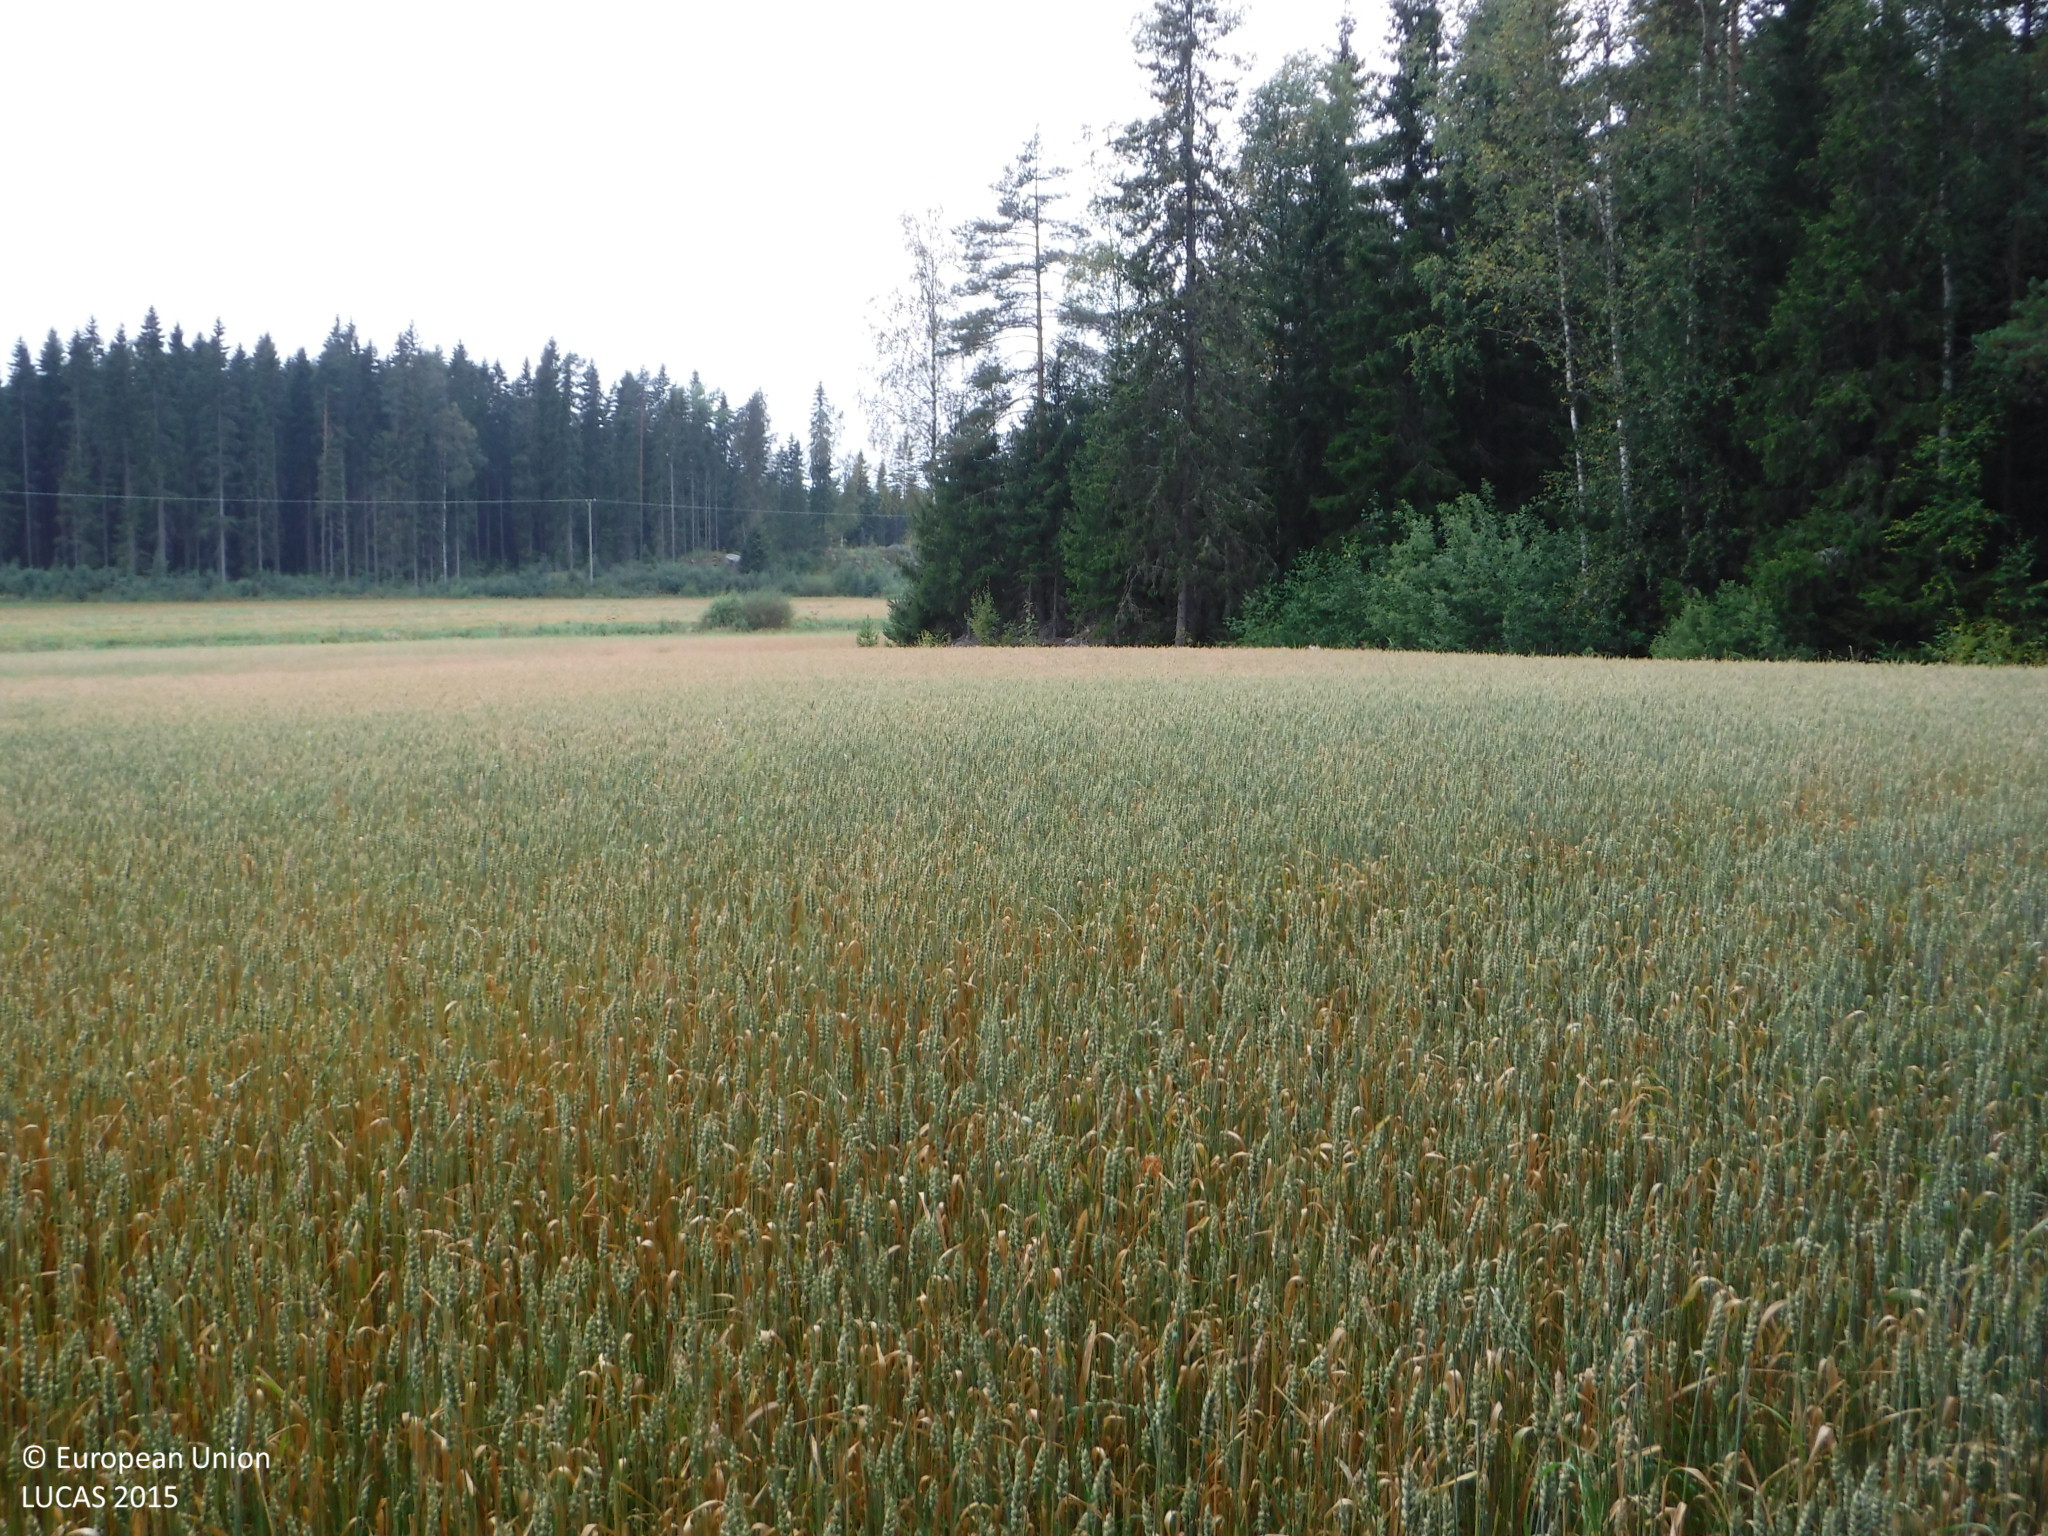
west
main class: Cropland
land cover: Common wheat
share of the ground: > 75 %
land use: Agriculture (excluding fallow land and kitchen gardens)
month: August
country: FI
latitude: 61.2415
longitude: 22.9850
